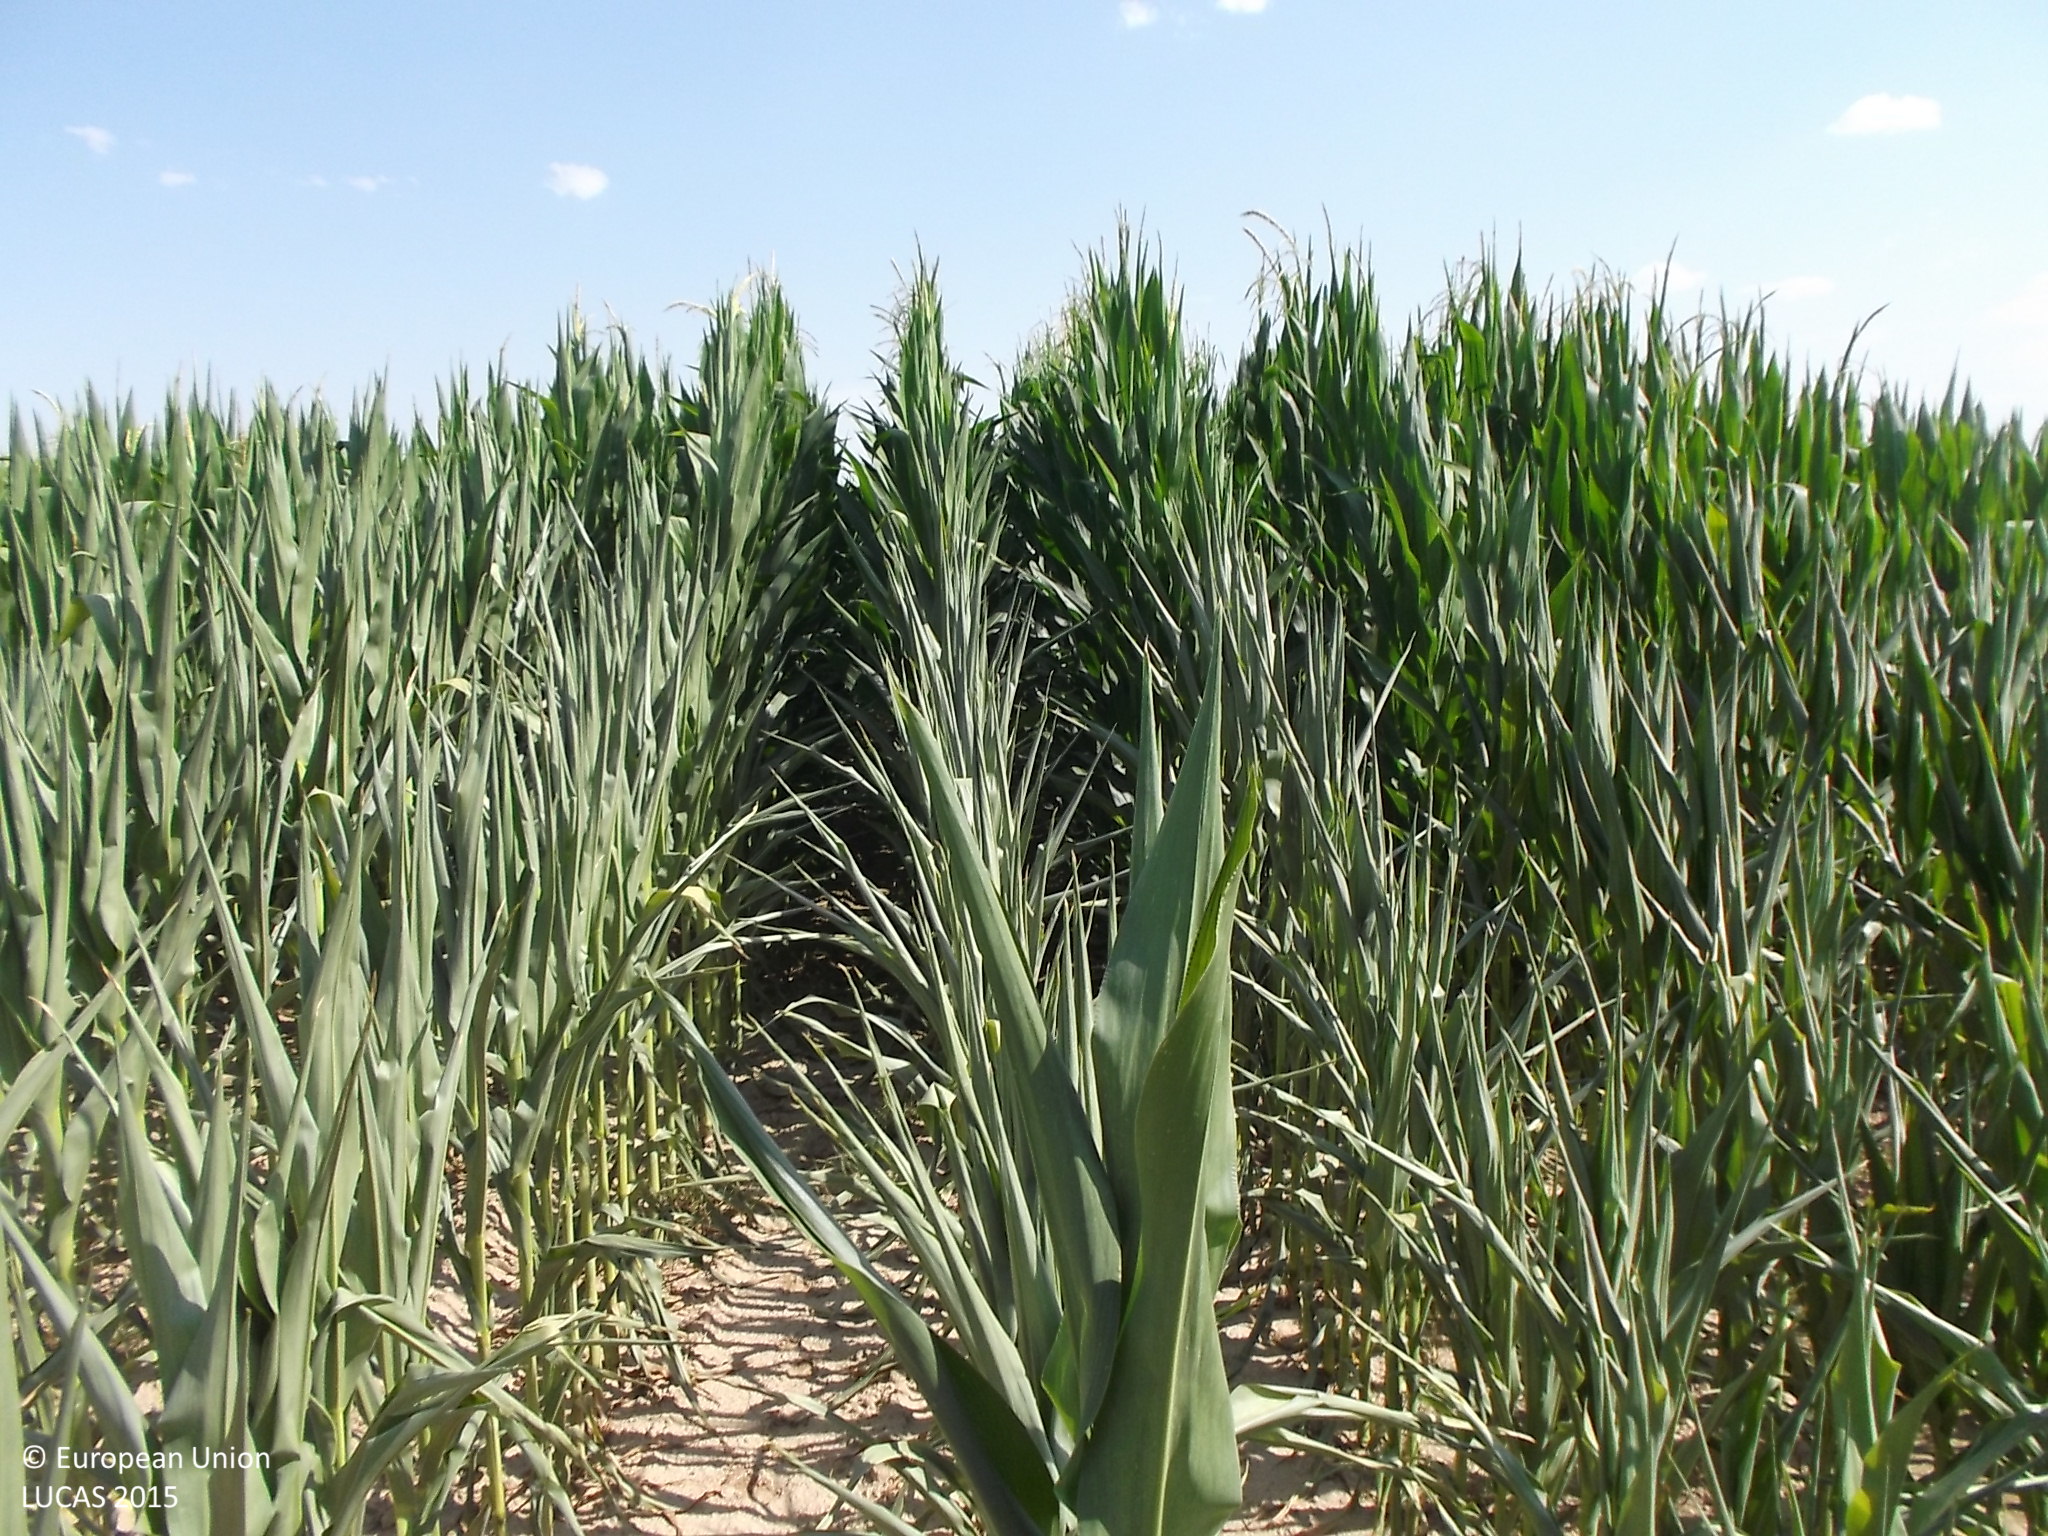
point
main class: Cropland
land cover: Maize
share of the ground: > 75 %
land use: Agriculture (excluding fallow land and kitchen gardens)
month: July
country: ES
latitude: 41.4484
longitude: -5.2906
